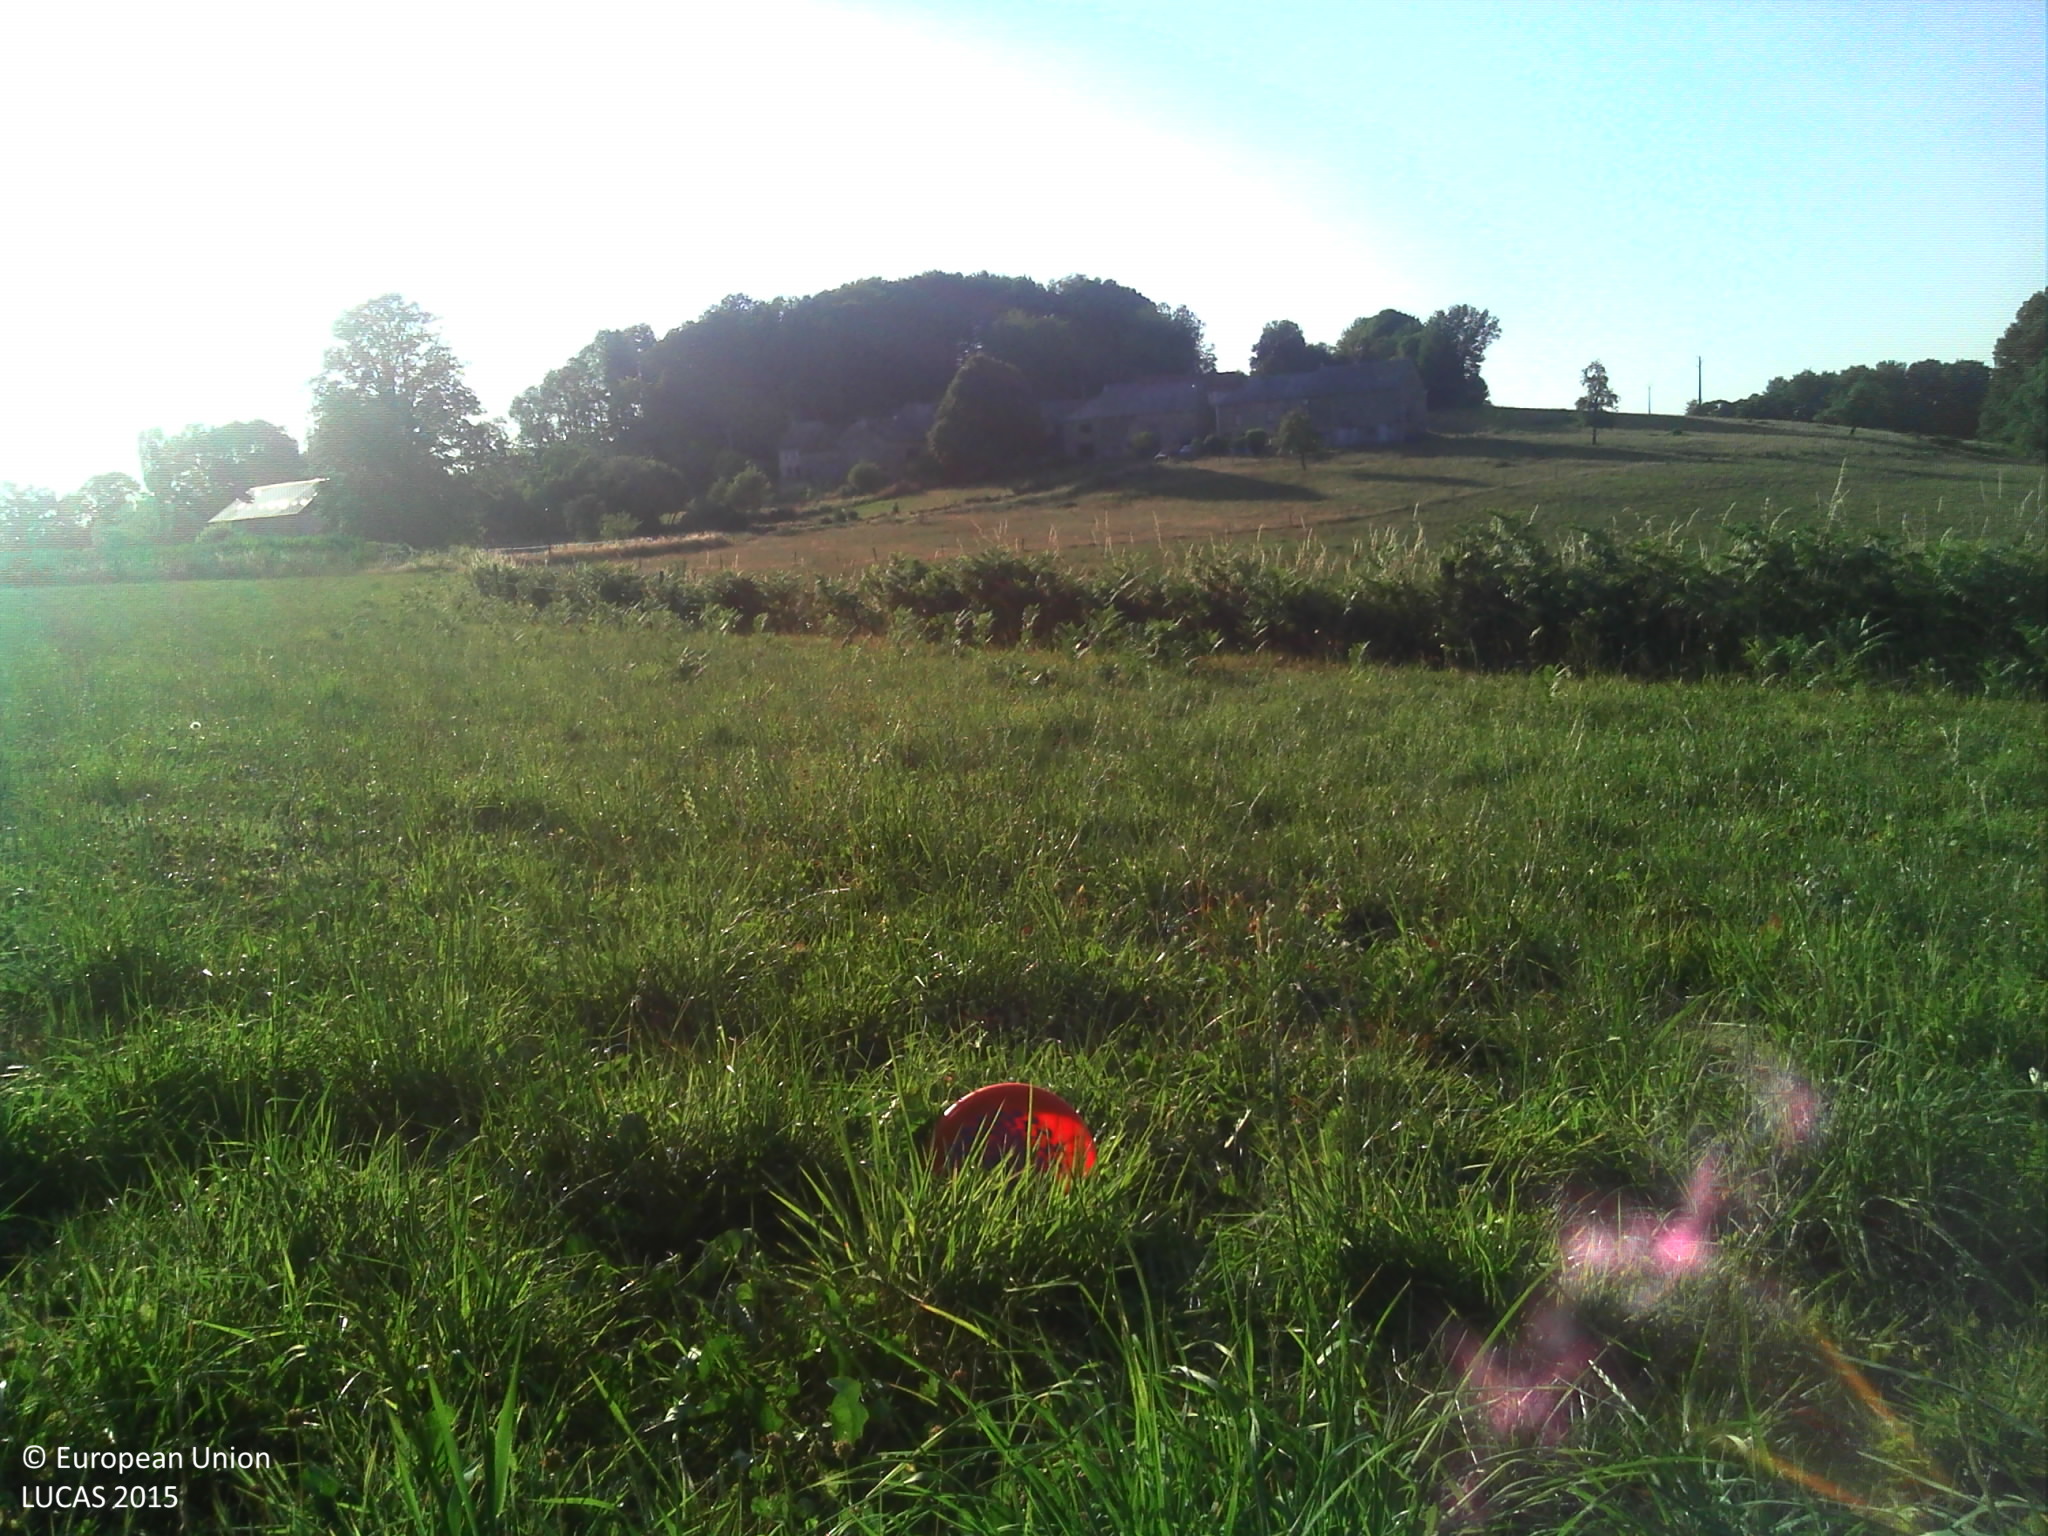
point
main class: Grassland
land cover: Grassland without tree/shrub cover
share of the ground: > 75 %
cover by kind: herbaceous plants 100 %
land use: Agriculture (excluding fallow land and kitchen gardens)
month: July
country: FR
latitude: 46.0629
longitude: 1.6803
